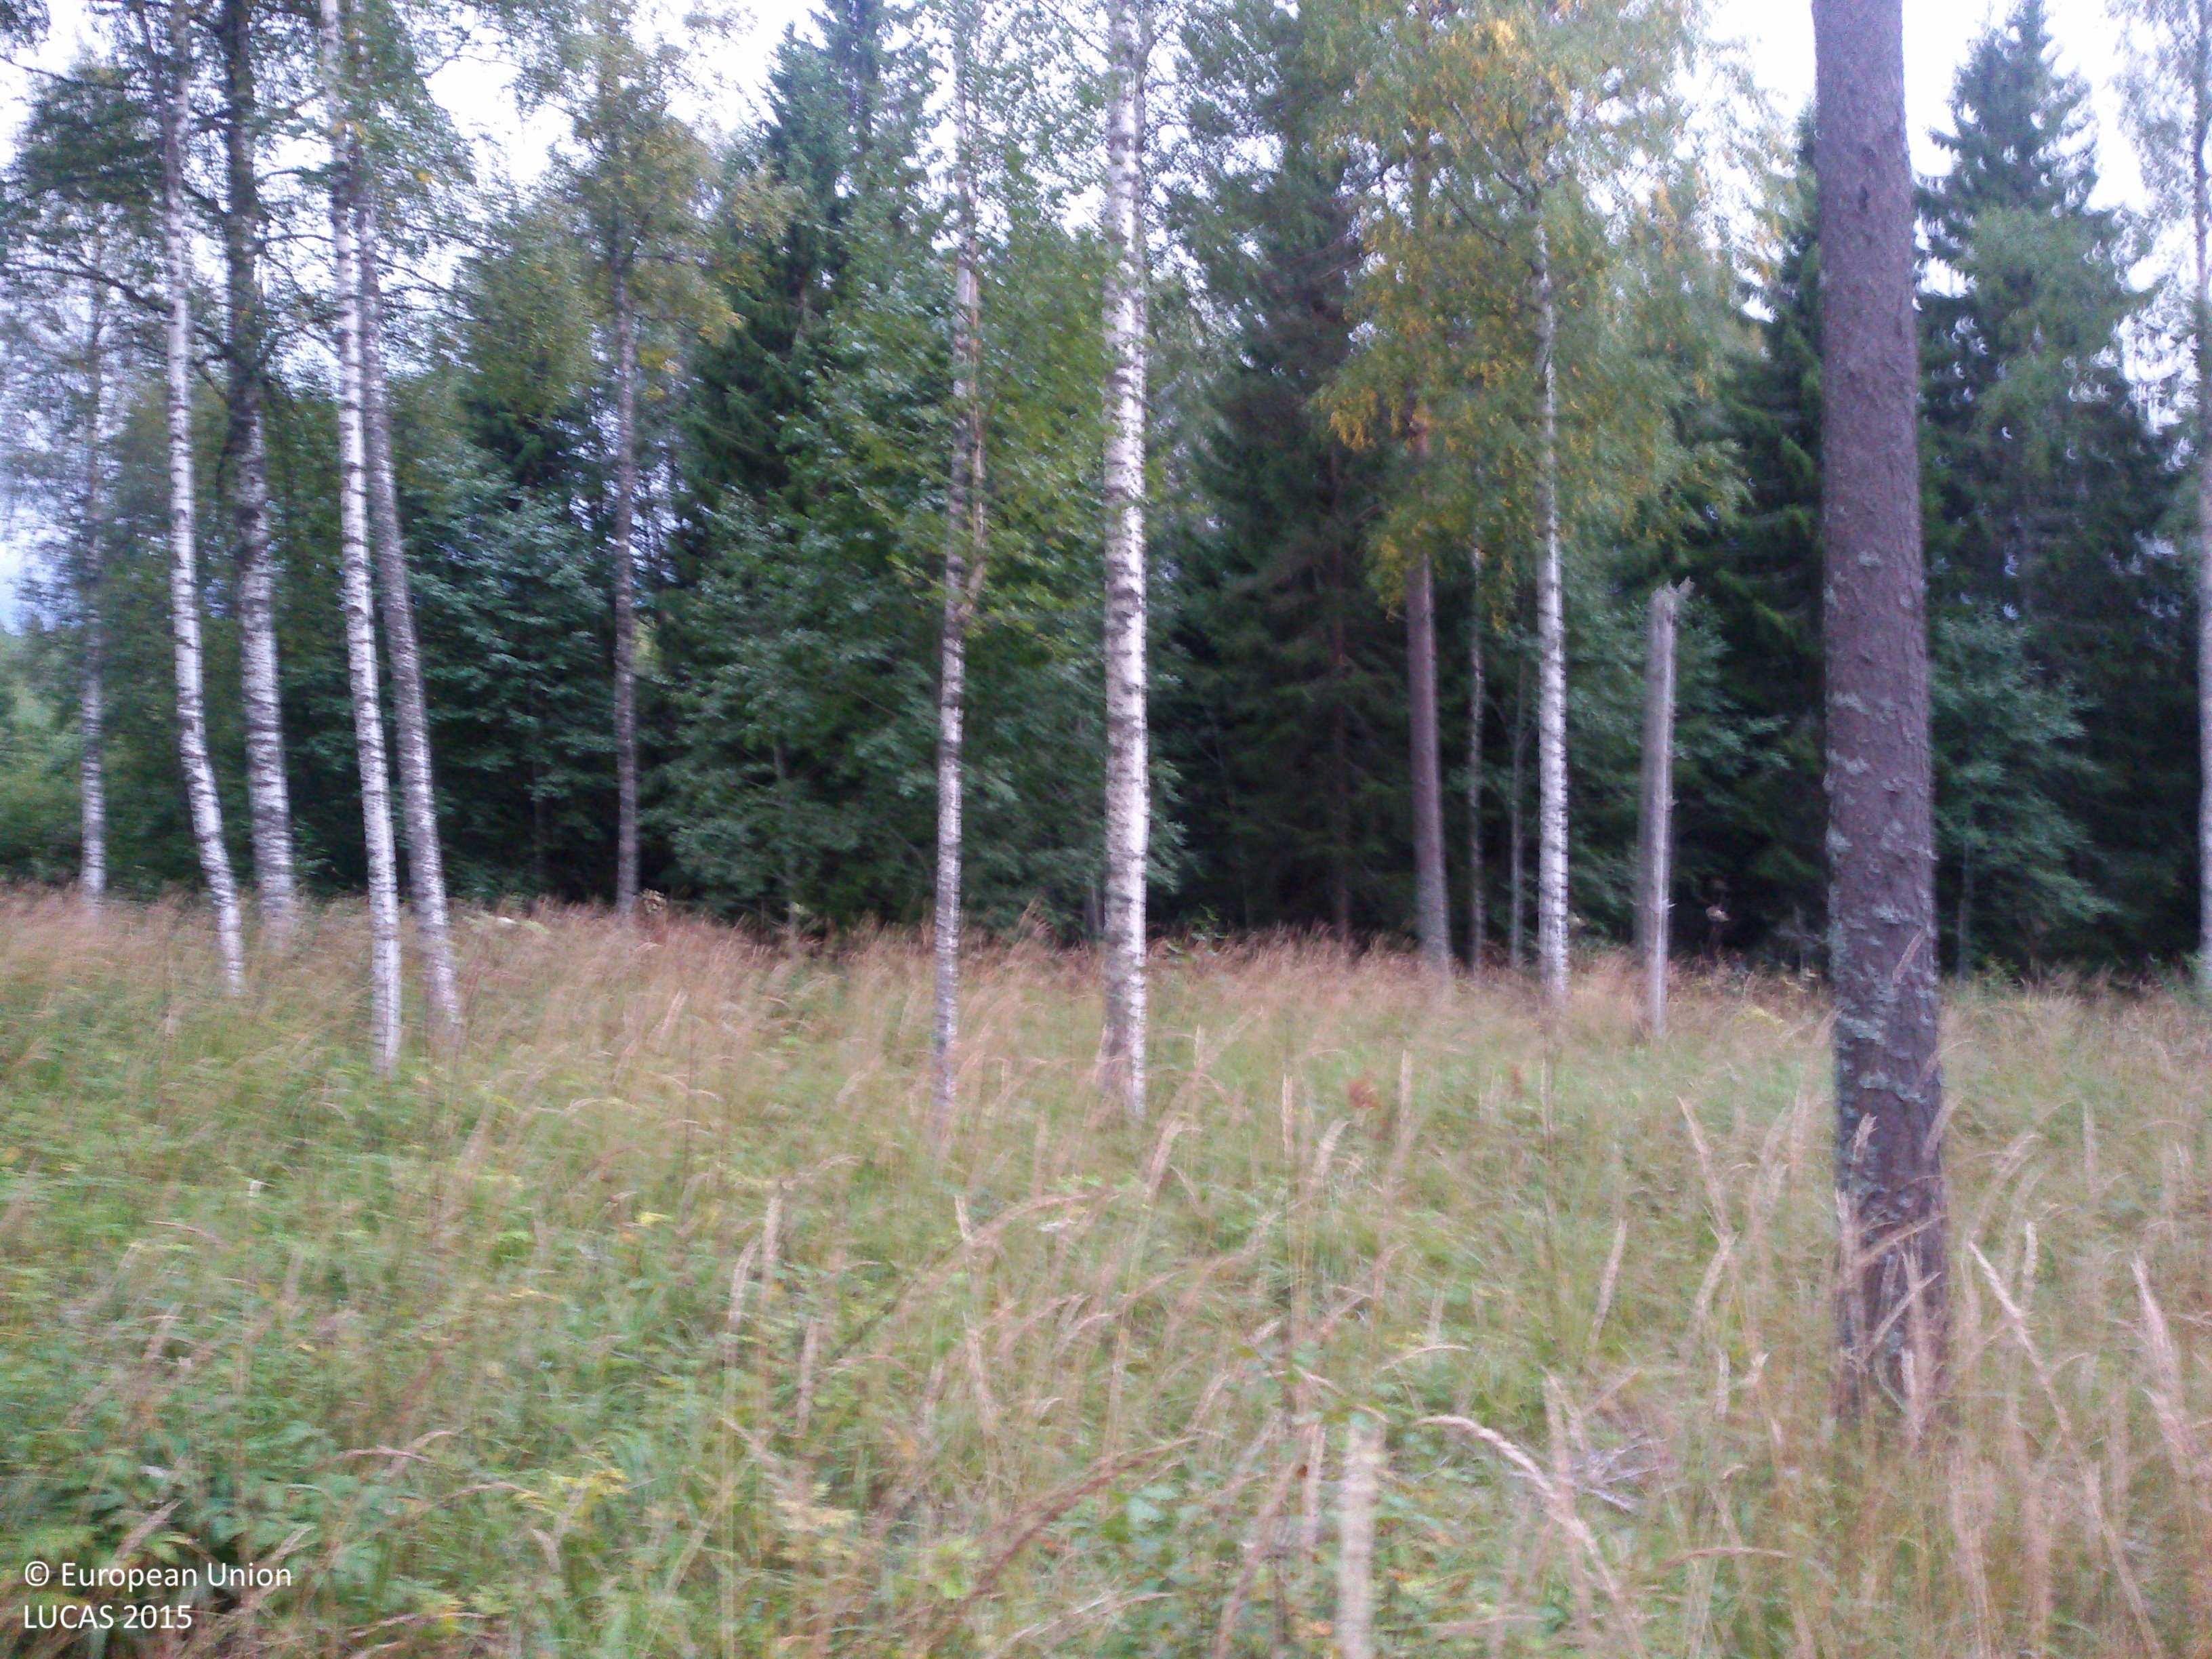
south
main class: Woodland
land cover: Pine dominated mixed woodland
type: boreal forest
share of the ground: 25 - 50 %
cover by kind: herbaceous plants 70 %, coniferous forest trees 15 %, broadleaved forest trees 15 %
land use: Forestry
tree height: > 5 m
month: September
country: SE
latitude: 60.8184
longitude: 15.3737
